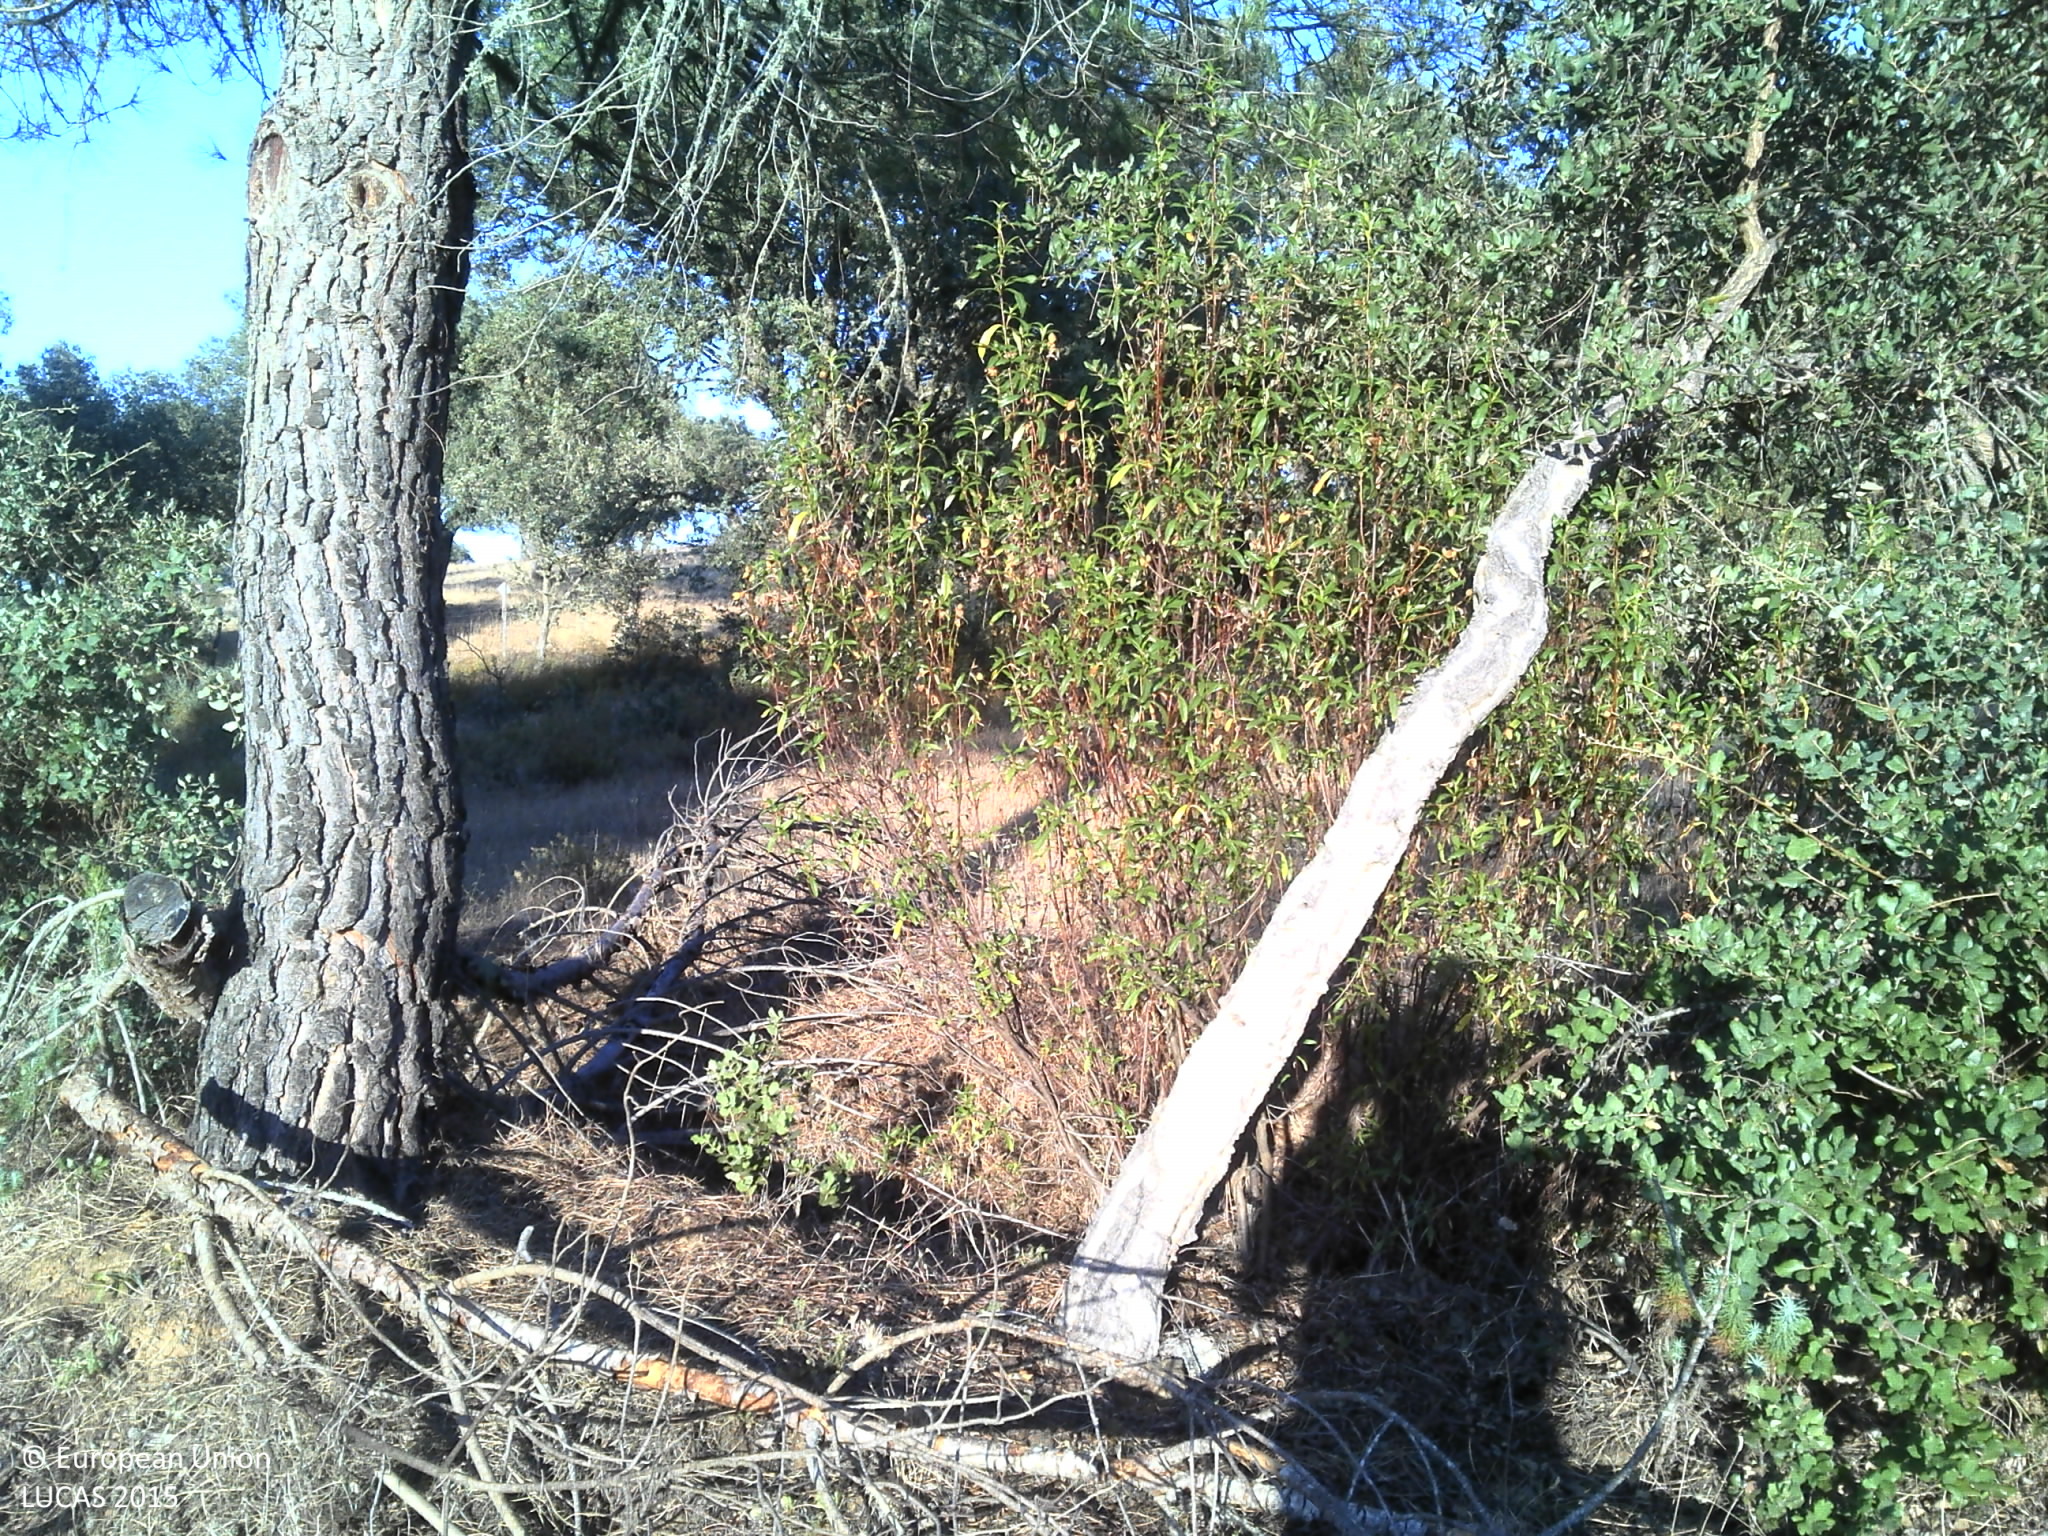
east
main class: Woodland
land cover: Other mixed woodland
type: broadleaved evergreen forest
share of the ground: 50 - 75 %
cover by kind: broadleaved forest trees 50 %, coniferous forest trees 35 %, herbaceous plants 15 %
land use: Forestry
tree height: > 5 m
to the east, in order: Other mixed woodland; Broadleaved woodland; Tracks; Broadleaved woodland; Fences; Broadleaved woodland; Other structural elements; Broadleaved woodland; Shrubland with sparse tree cover
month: June
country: PT
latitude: 38.0722
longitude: -7.1924
